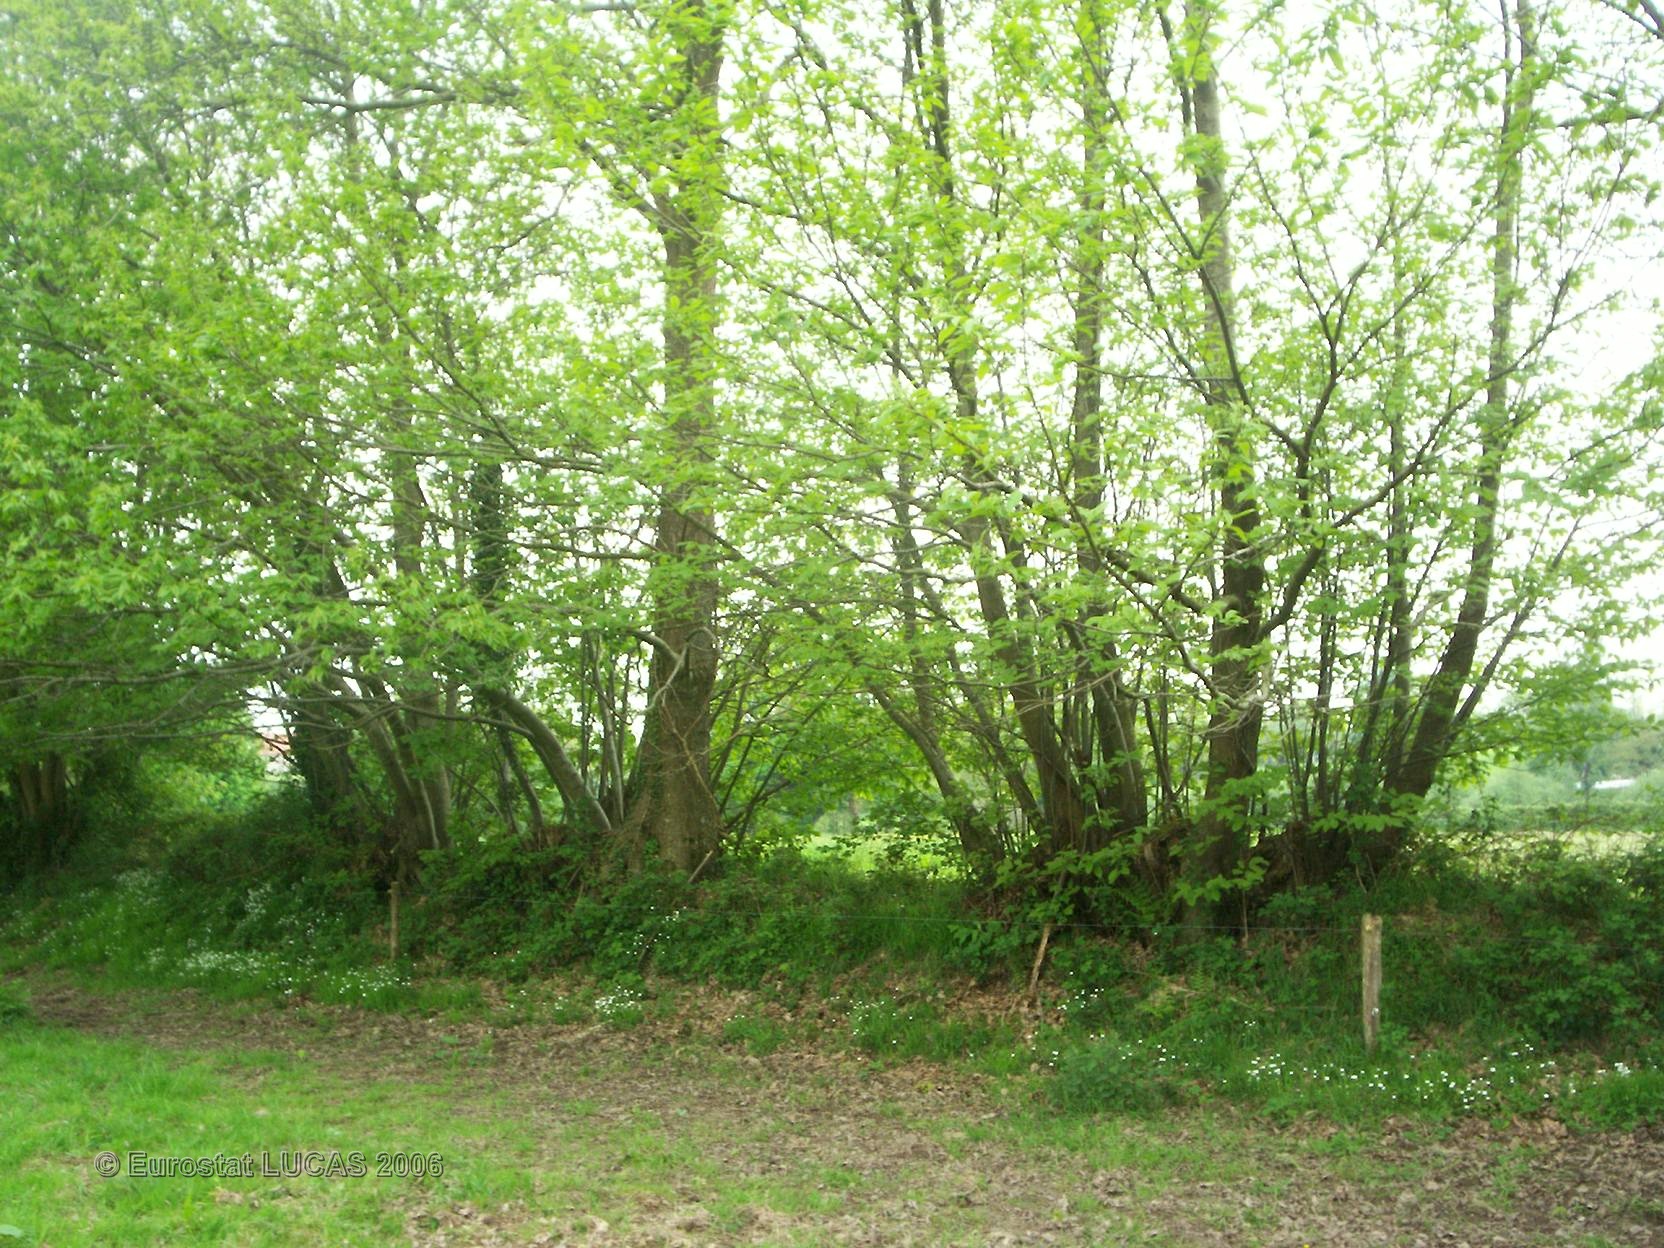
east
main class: Grassland
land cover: Grassland without tree/shrub cover
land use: Agriculture (excluding fallow land and kitchen gardens)
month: May
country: FR
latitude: 48.7794
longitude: -1.3548
